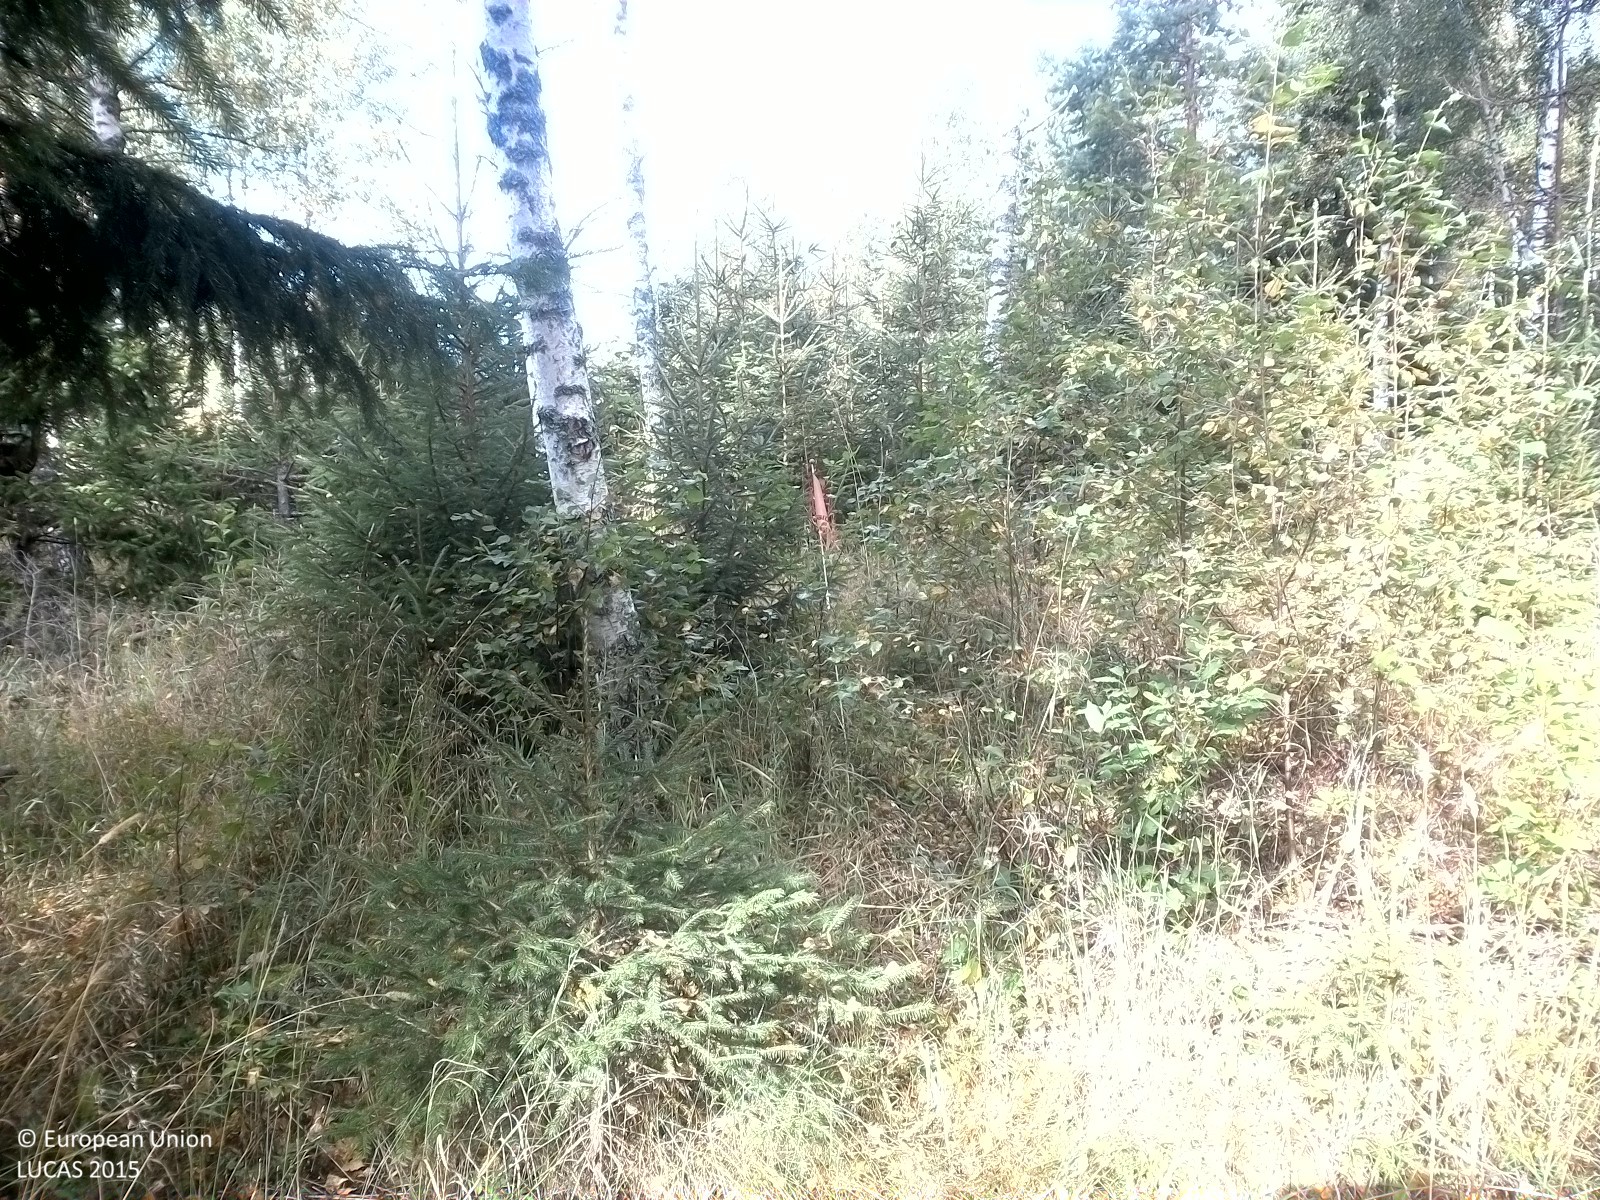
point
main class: Woodland
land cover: Spruce dominated mixed woodland
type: boreal forest
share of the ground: 50 - 75 %
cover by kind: herbaceous plants 35 %, coniferous forest trees 30 %, broadleaved forest trees 30 %, lichens and mosses 5 %
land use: Forestry
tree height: > 5 m
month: August
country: SE
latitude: 58.6849
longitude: 15.0130
